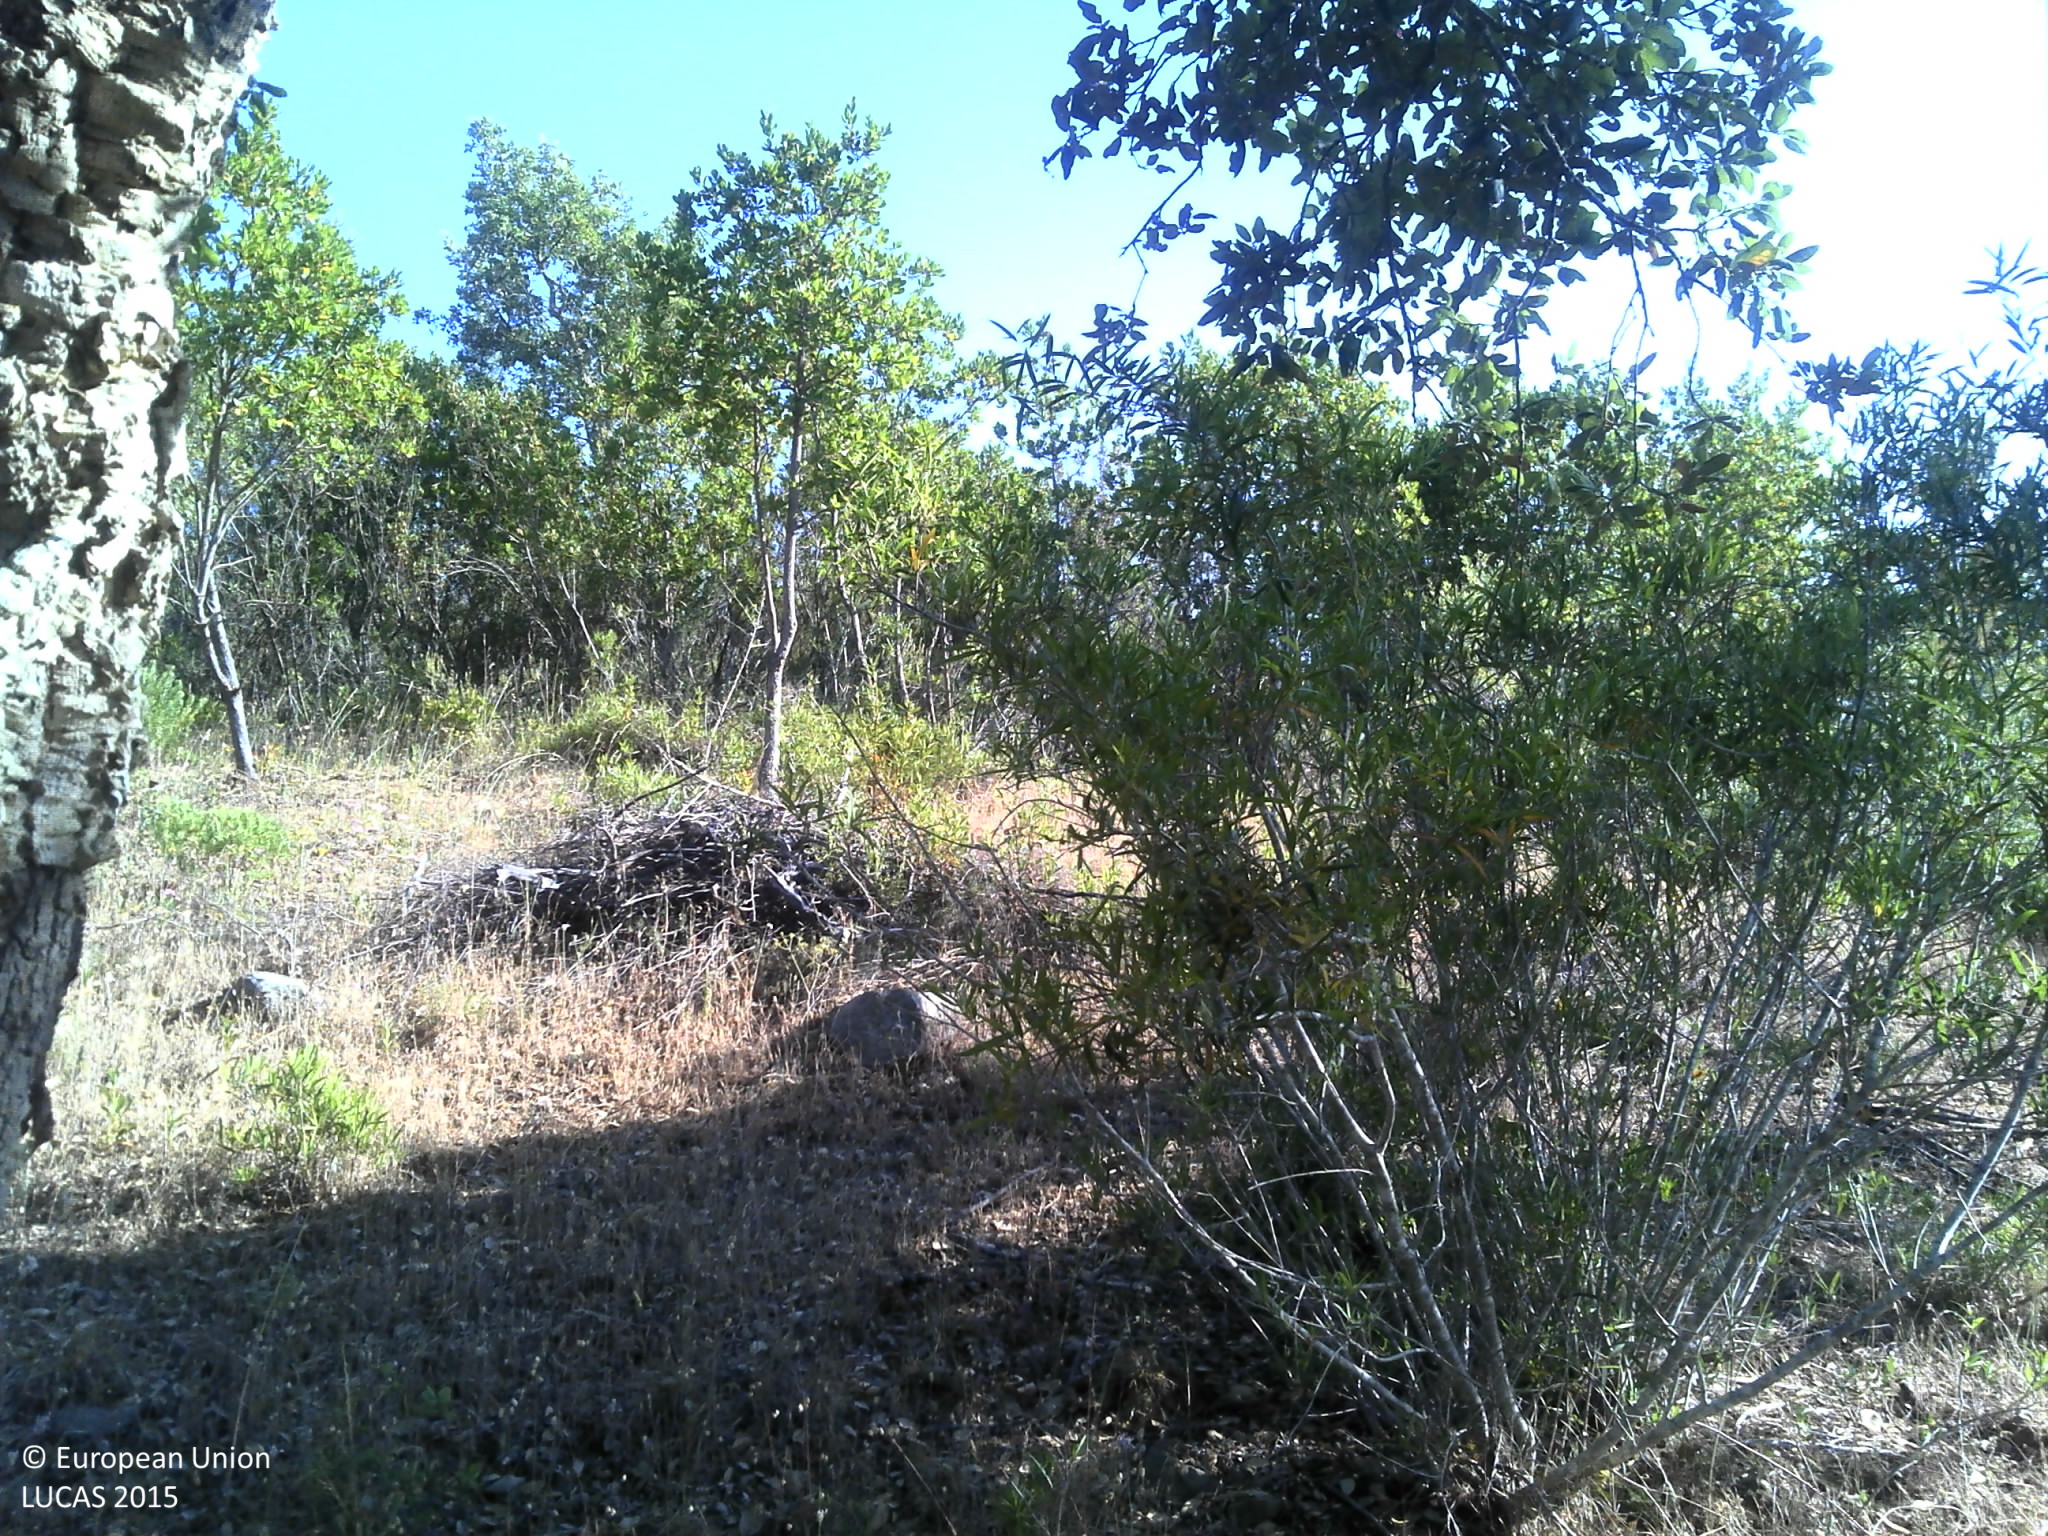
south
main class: Woodland
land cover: Broadleaved woodland
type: broadleaved evergreen forest
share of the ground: 50 - 75 %
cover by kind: broadleaved forest trees 60 %, herbaceous plants 20 %, unconsolidated bare surface 20 %
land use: Forestry
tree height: > 5 m
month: May
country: PT
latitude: 38.1880
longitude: -8.6259
